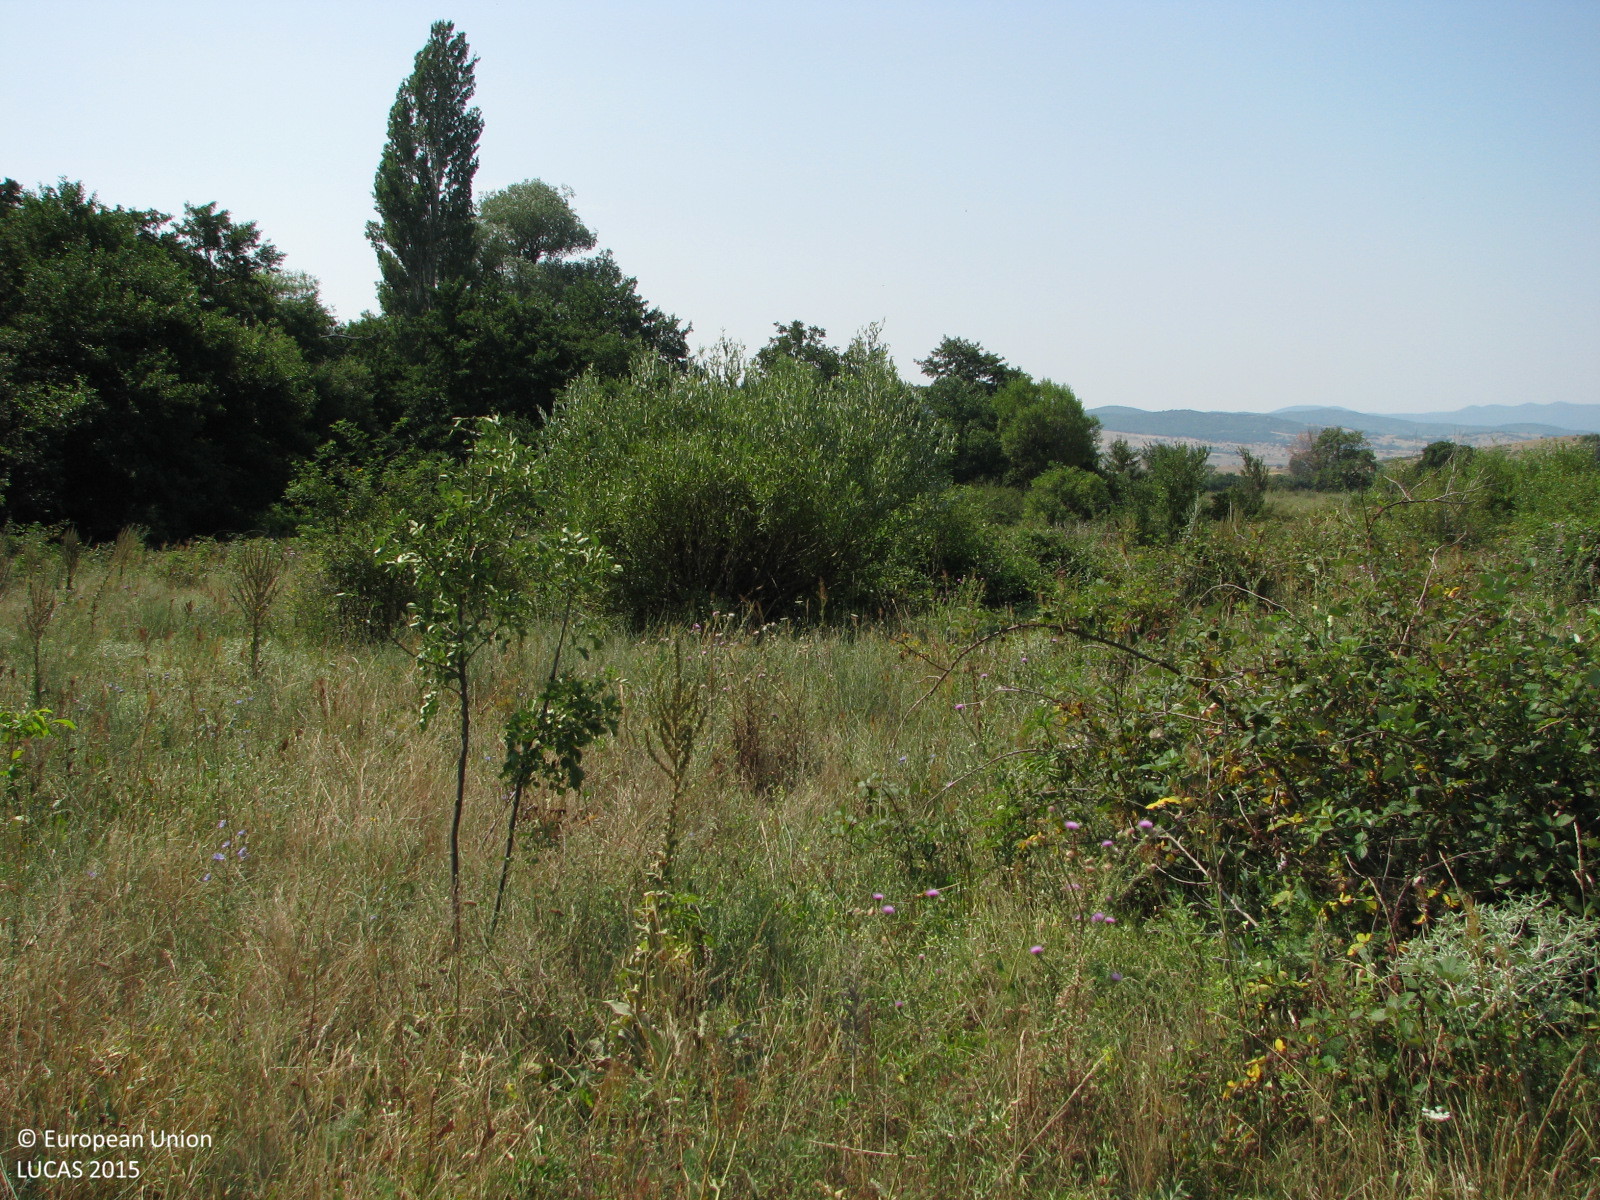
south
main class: Grassland
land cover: Grassland with sparse tree/shrub cover
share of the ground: > 75 %
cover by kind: herbaceous plants 90 %, broadleaved forest trees 5 %, shrubs 5 %
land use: Abandoned areas
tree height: < 5 m
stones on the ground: < 10 %
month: July
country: BG
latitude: 42.6871
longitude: 25.9360
